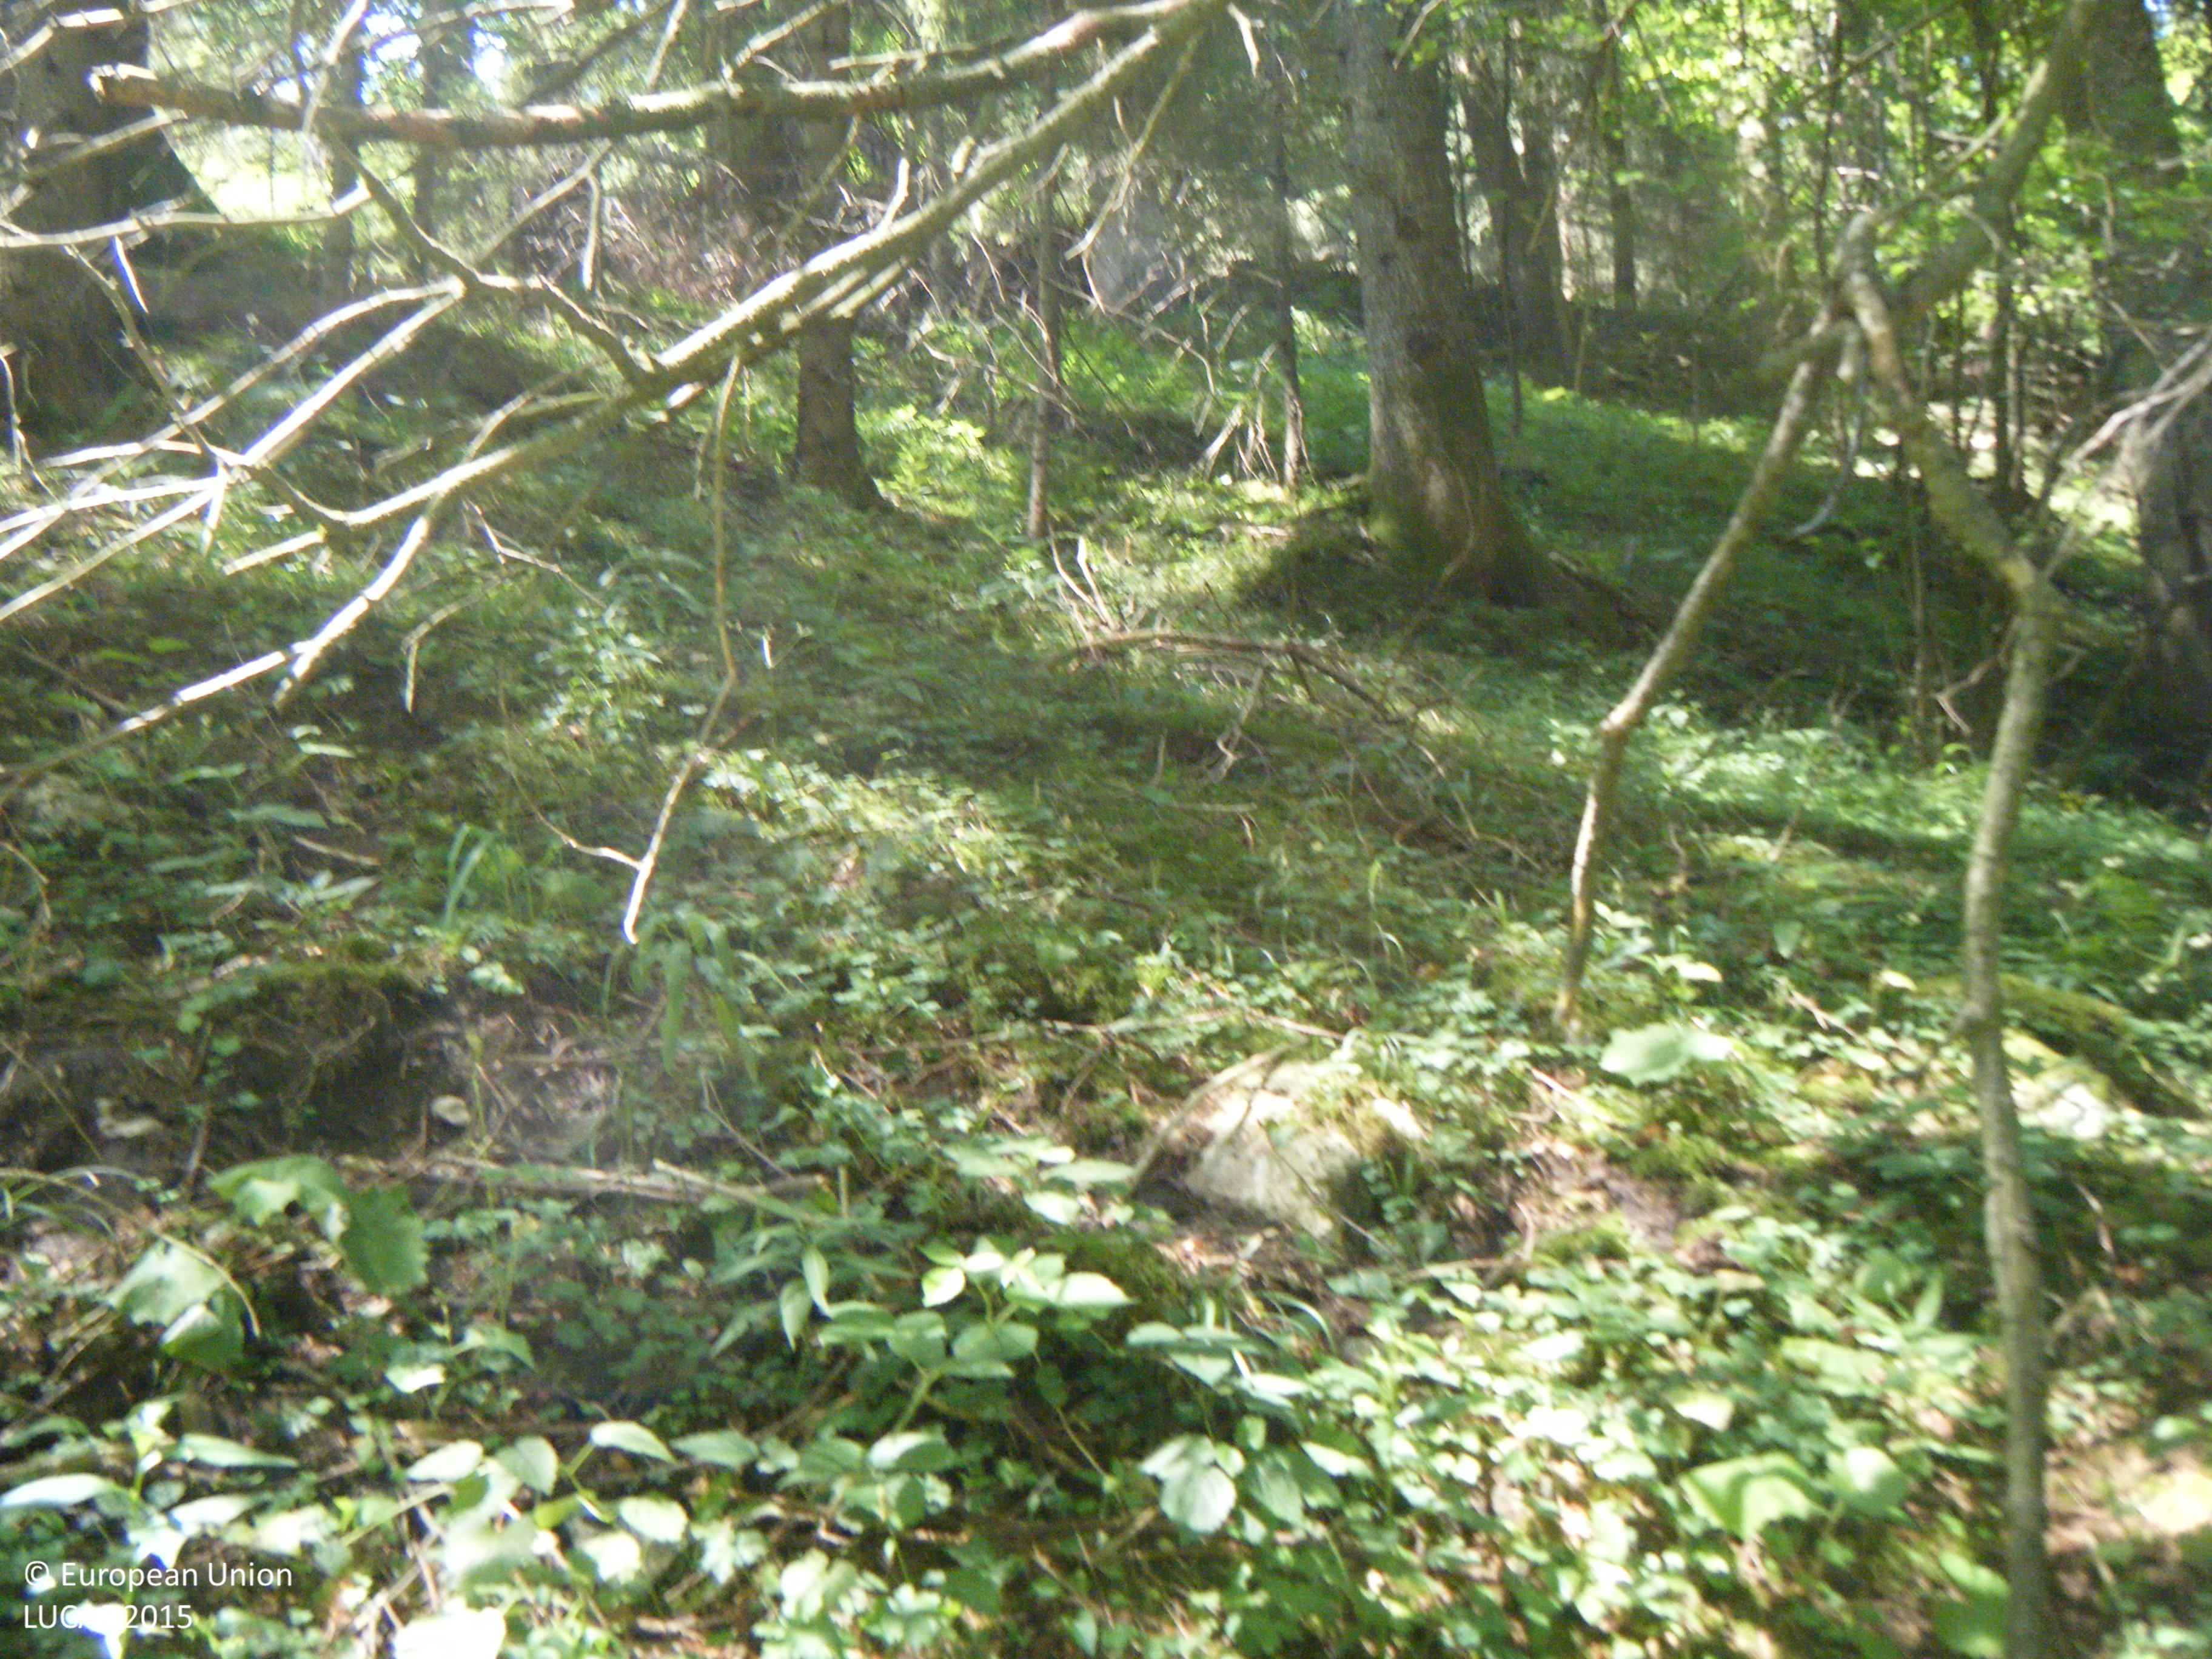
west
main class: Woodland
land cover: Spruce dominated mixed woodland
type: alpine coniferous forest
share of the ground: > 75 %
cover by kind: coniferous forest trees 60 %, broadleaved forest trees 25 %, herbaceous plants 15 %
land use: Forestry
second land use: Agriculture (excluding fallow land and kitchen gardens)
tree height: > 5 m
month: July
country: AT
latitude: 47.7593
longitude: 13.3205
